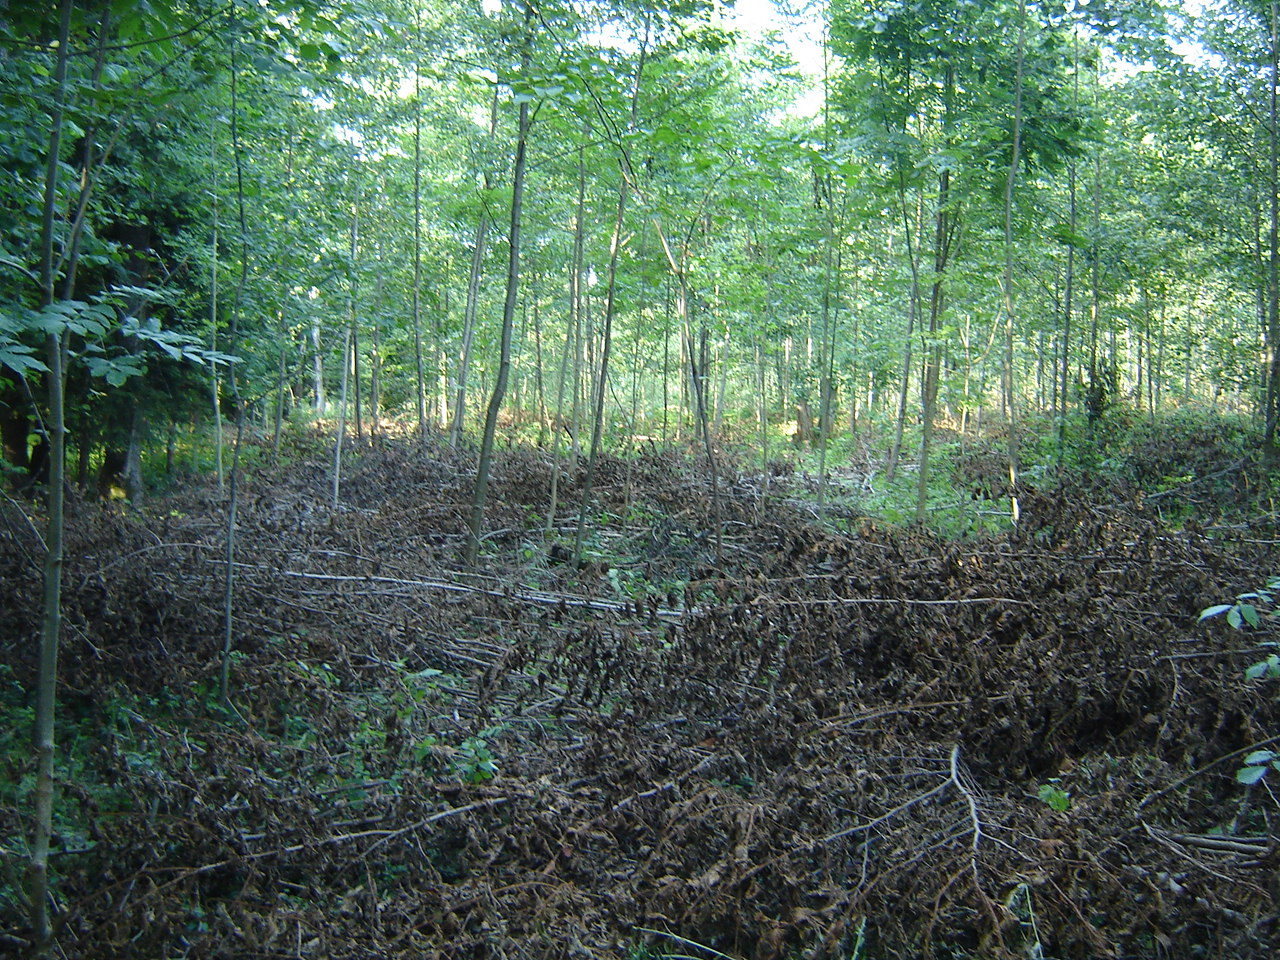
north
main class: Woodland
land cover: Broadleaved woodland
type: non-riverine alder, birch or aspen forest
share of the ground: > 75 %
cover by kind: broadleaved forest trees 80 %, unconsolidated bare surface 10 %, coniferous forest trees 5 %, herbaceous plants 5 %
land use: Forestry
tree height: > 5 m
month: August
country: LT
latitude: 55.1064
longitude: 24.9237
